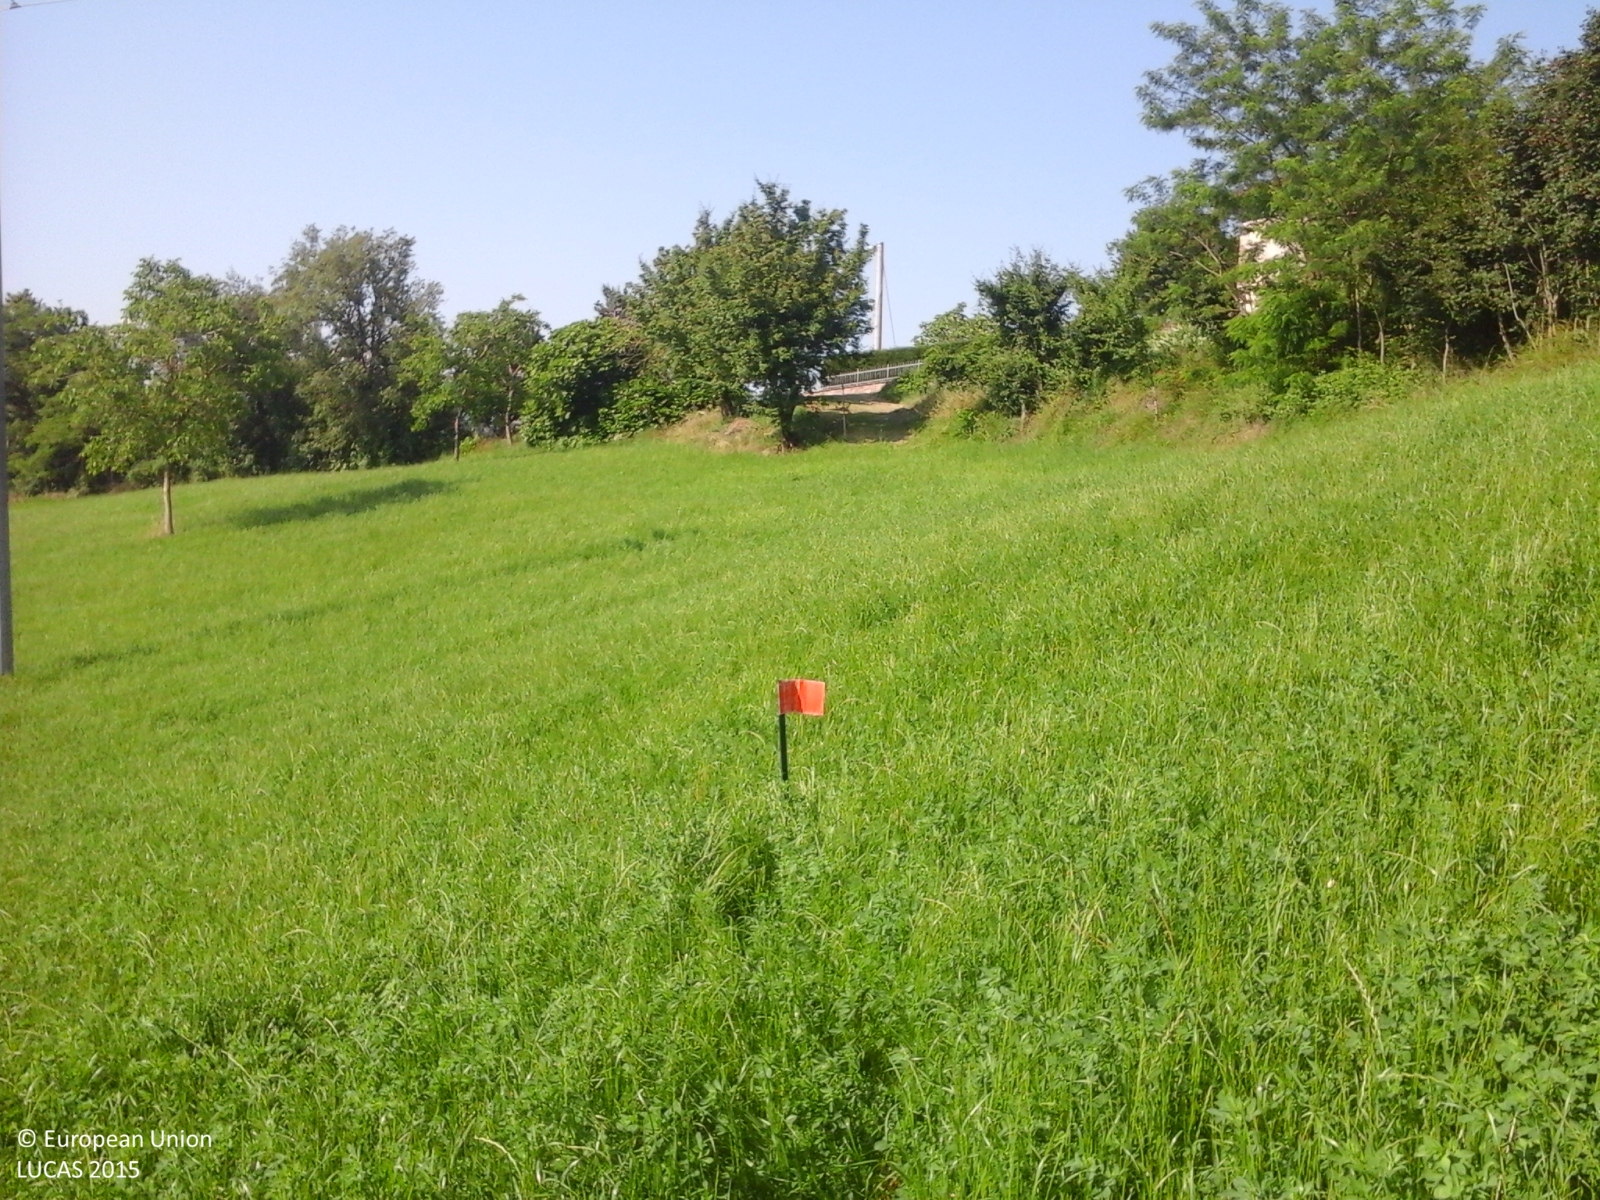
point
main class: Cropland
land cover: Lucerne
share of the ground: > 75 %
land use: Agriculture (excluding fallow land and kitchen gardens)
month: June
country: IT
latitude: 44.4209
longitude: 10.6140
